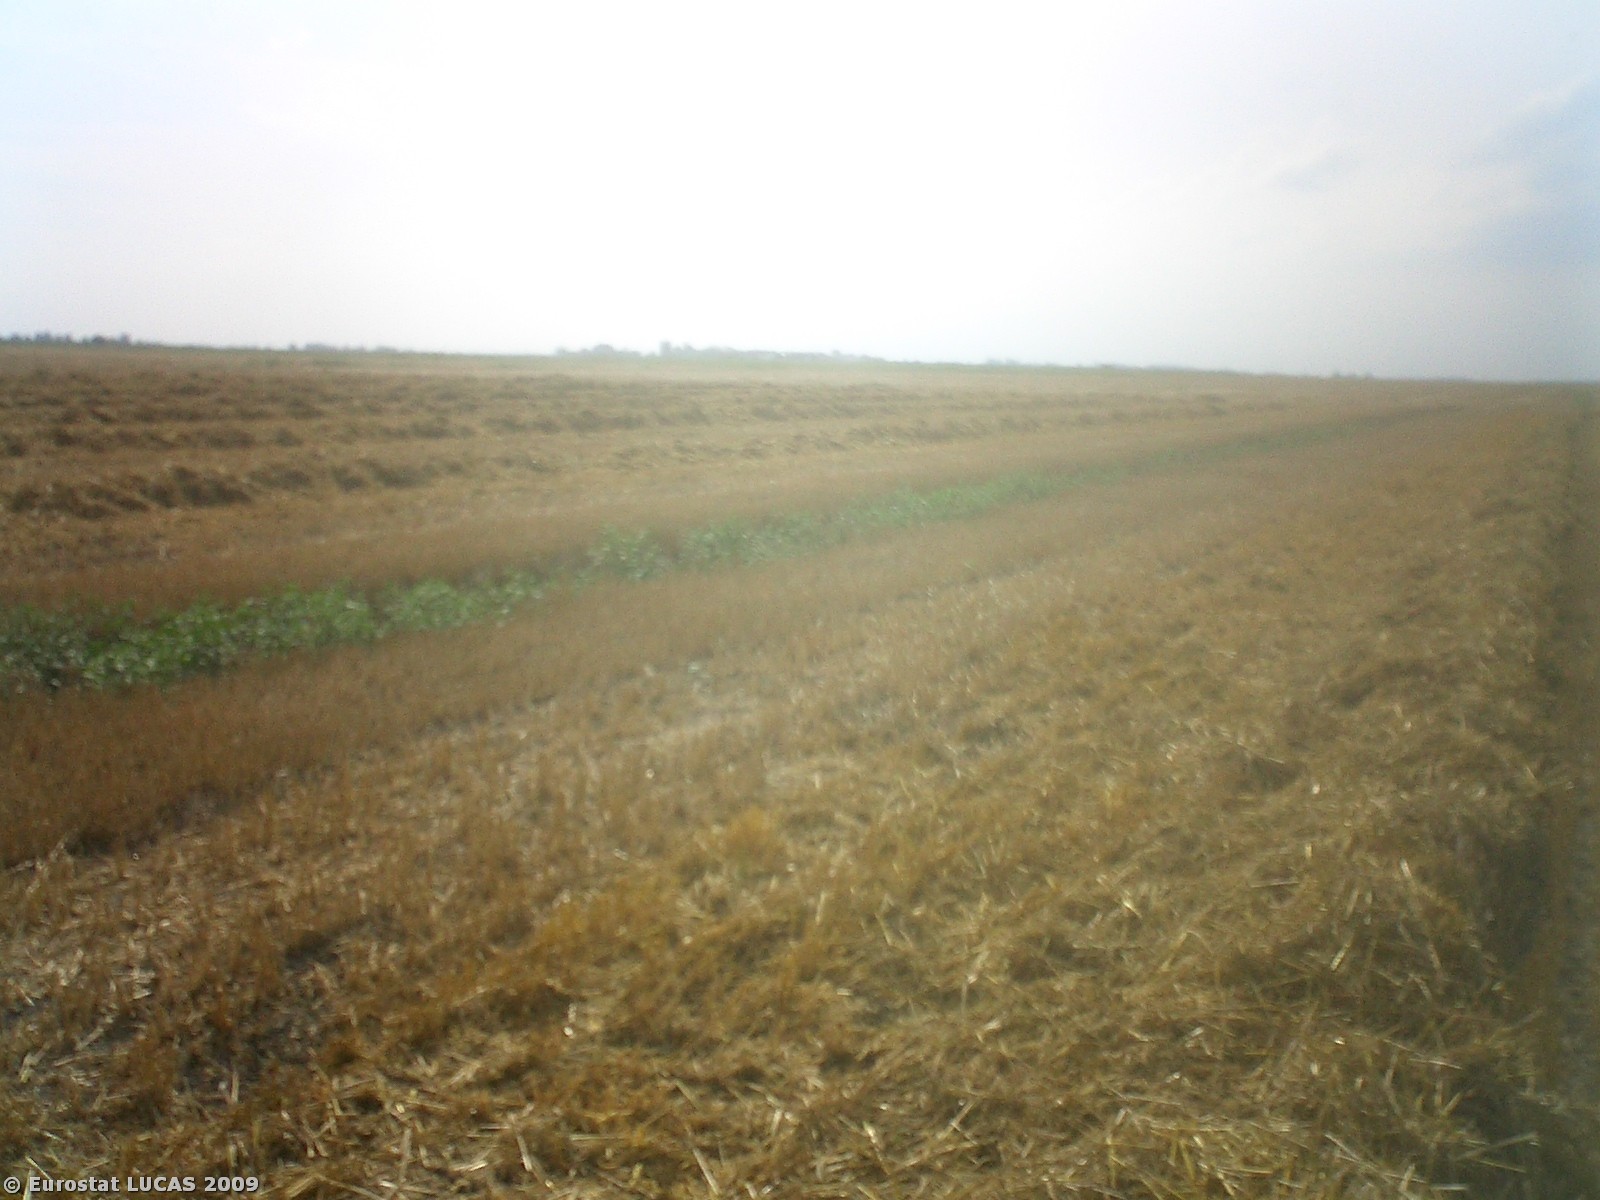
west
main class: Cropland
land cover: Common wheat
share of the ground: > 75 %
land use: Agriculture (excluding fallow land and kitchen gardens)
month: July
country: IT
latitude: 44.6204
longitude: 11.9746
